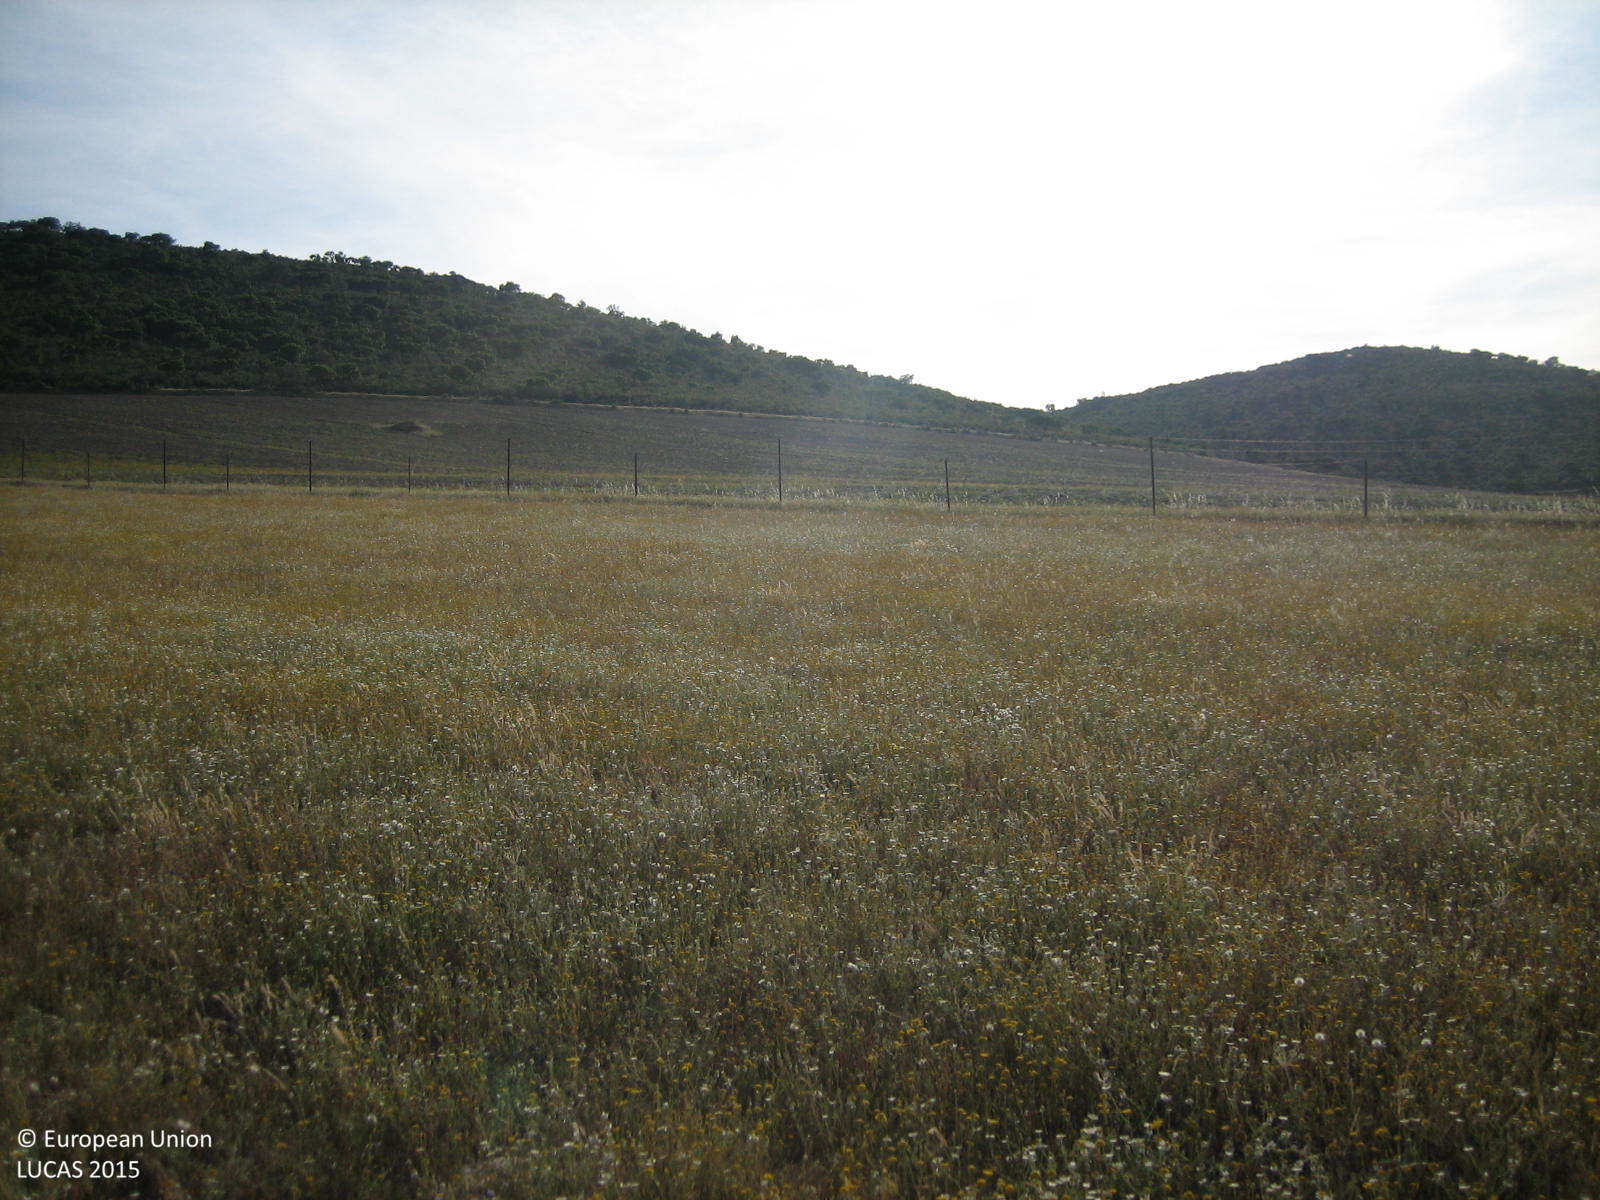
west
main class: Grassland
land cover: Spontaneously vegetated surfaces
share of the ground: > 75 %
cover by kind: herbaceous plants 100 %
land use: Agriculture (excluding fallow land and kitchen gardens)
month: May
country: ES
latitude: 39.0656
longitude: -4.7923
